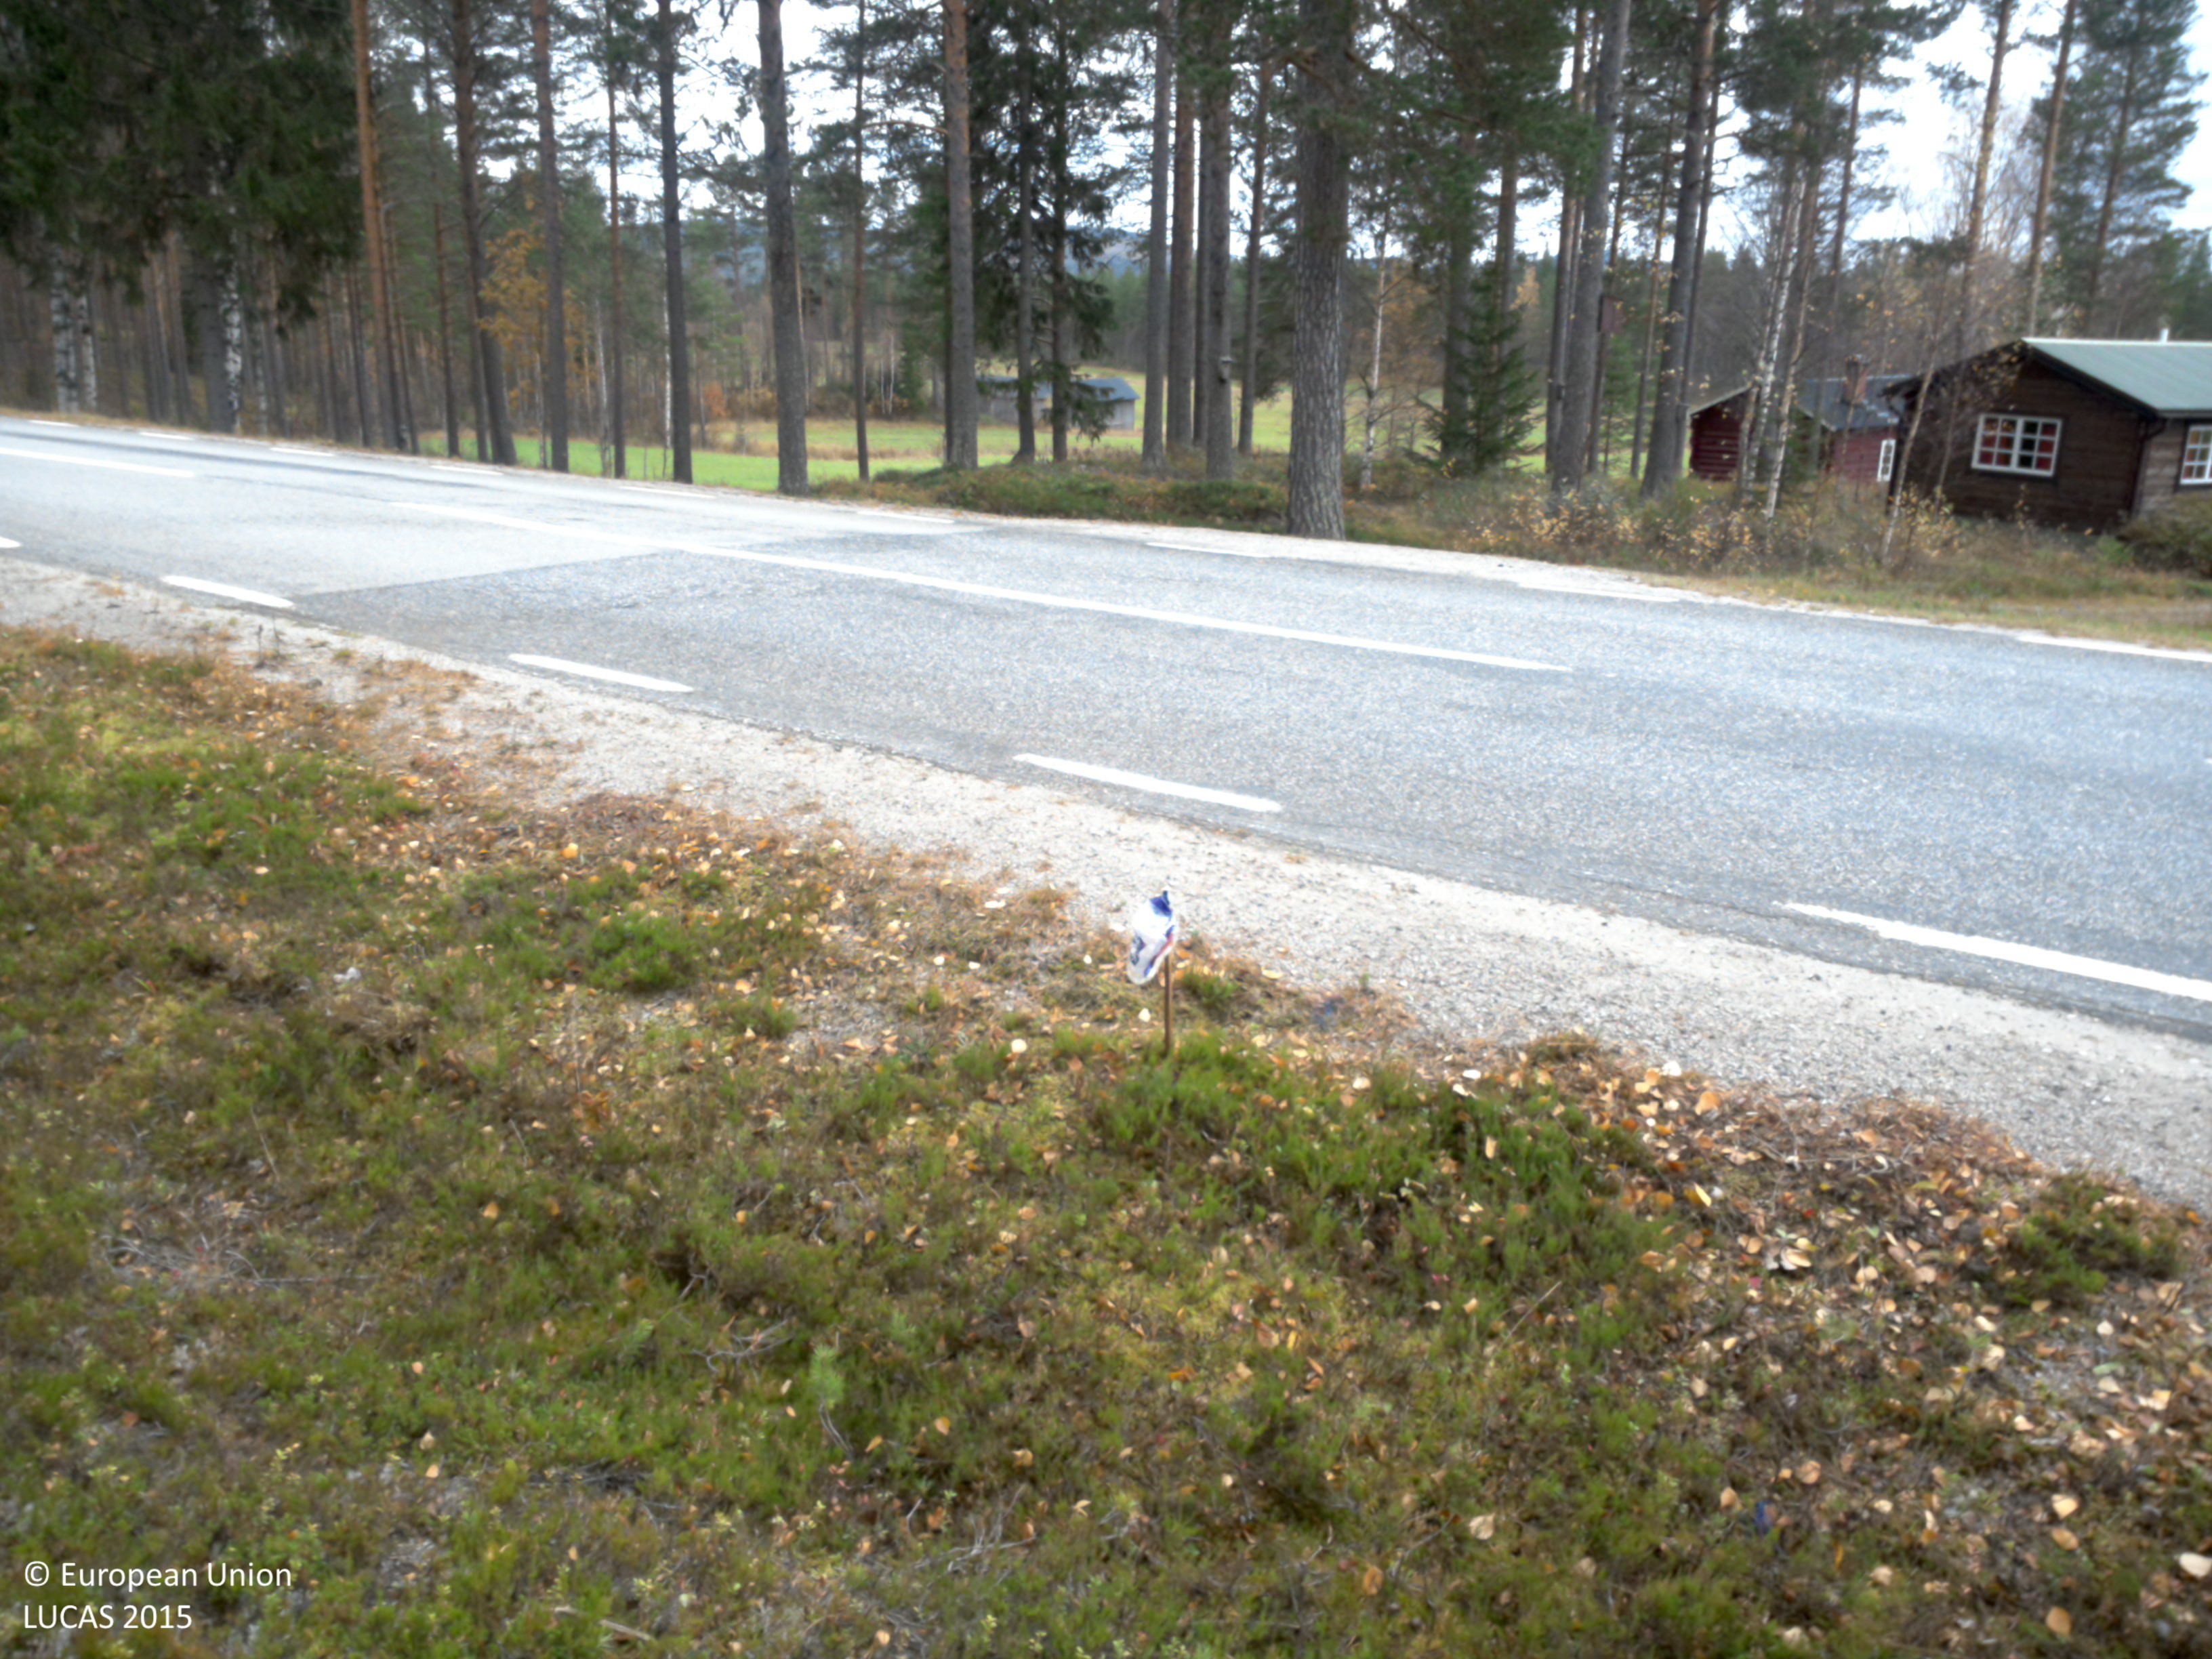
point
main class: Woodland
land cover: Pine dominated mixed woodland
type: boreal forest
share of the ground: > 75 %
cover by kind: coniferous forest trees 55 %, broadleaved forest trees 25 %, shrubs 10 %, herbaceous plants 5 %, lichens and mosses 5 %
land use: Forestry
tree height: > 5 m
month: September
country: SE
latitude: 64.7168
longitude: 19.1387
